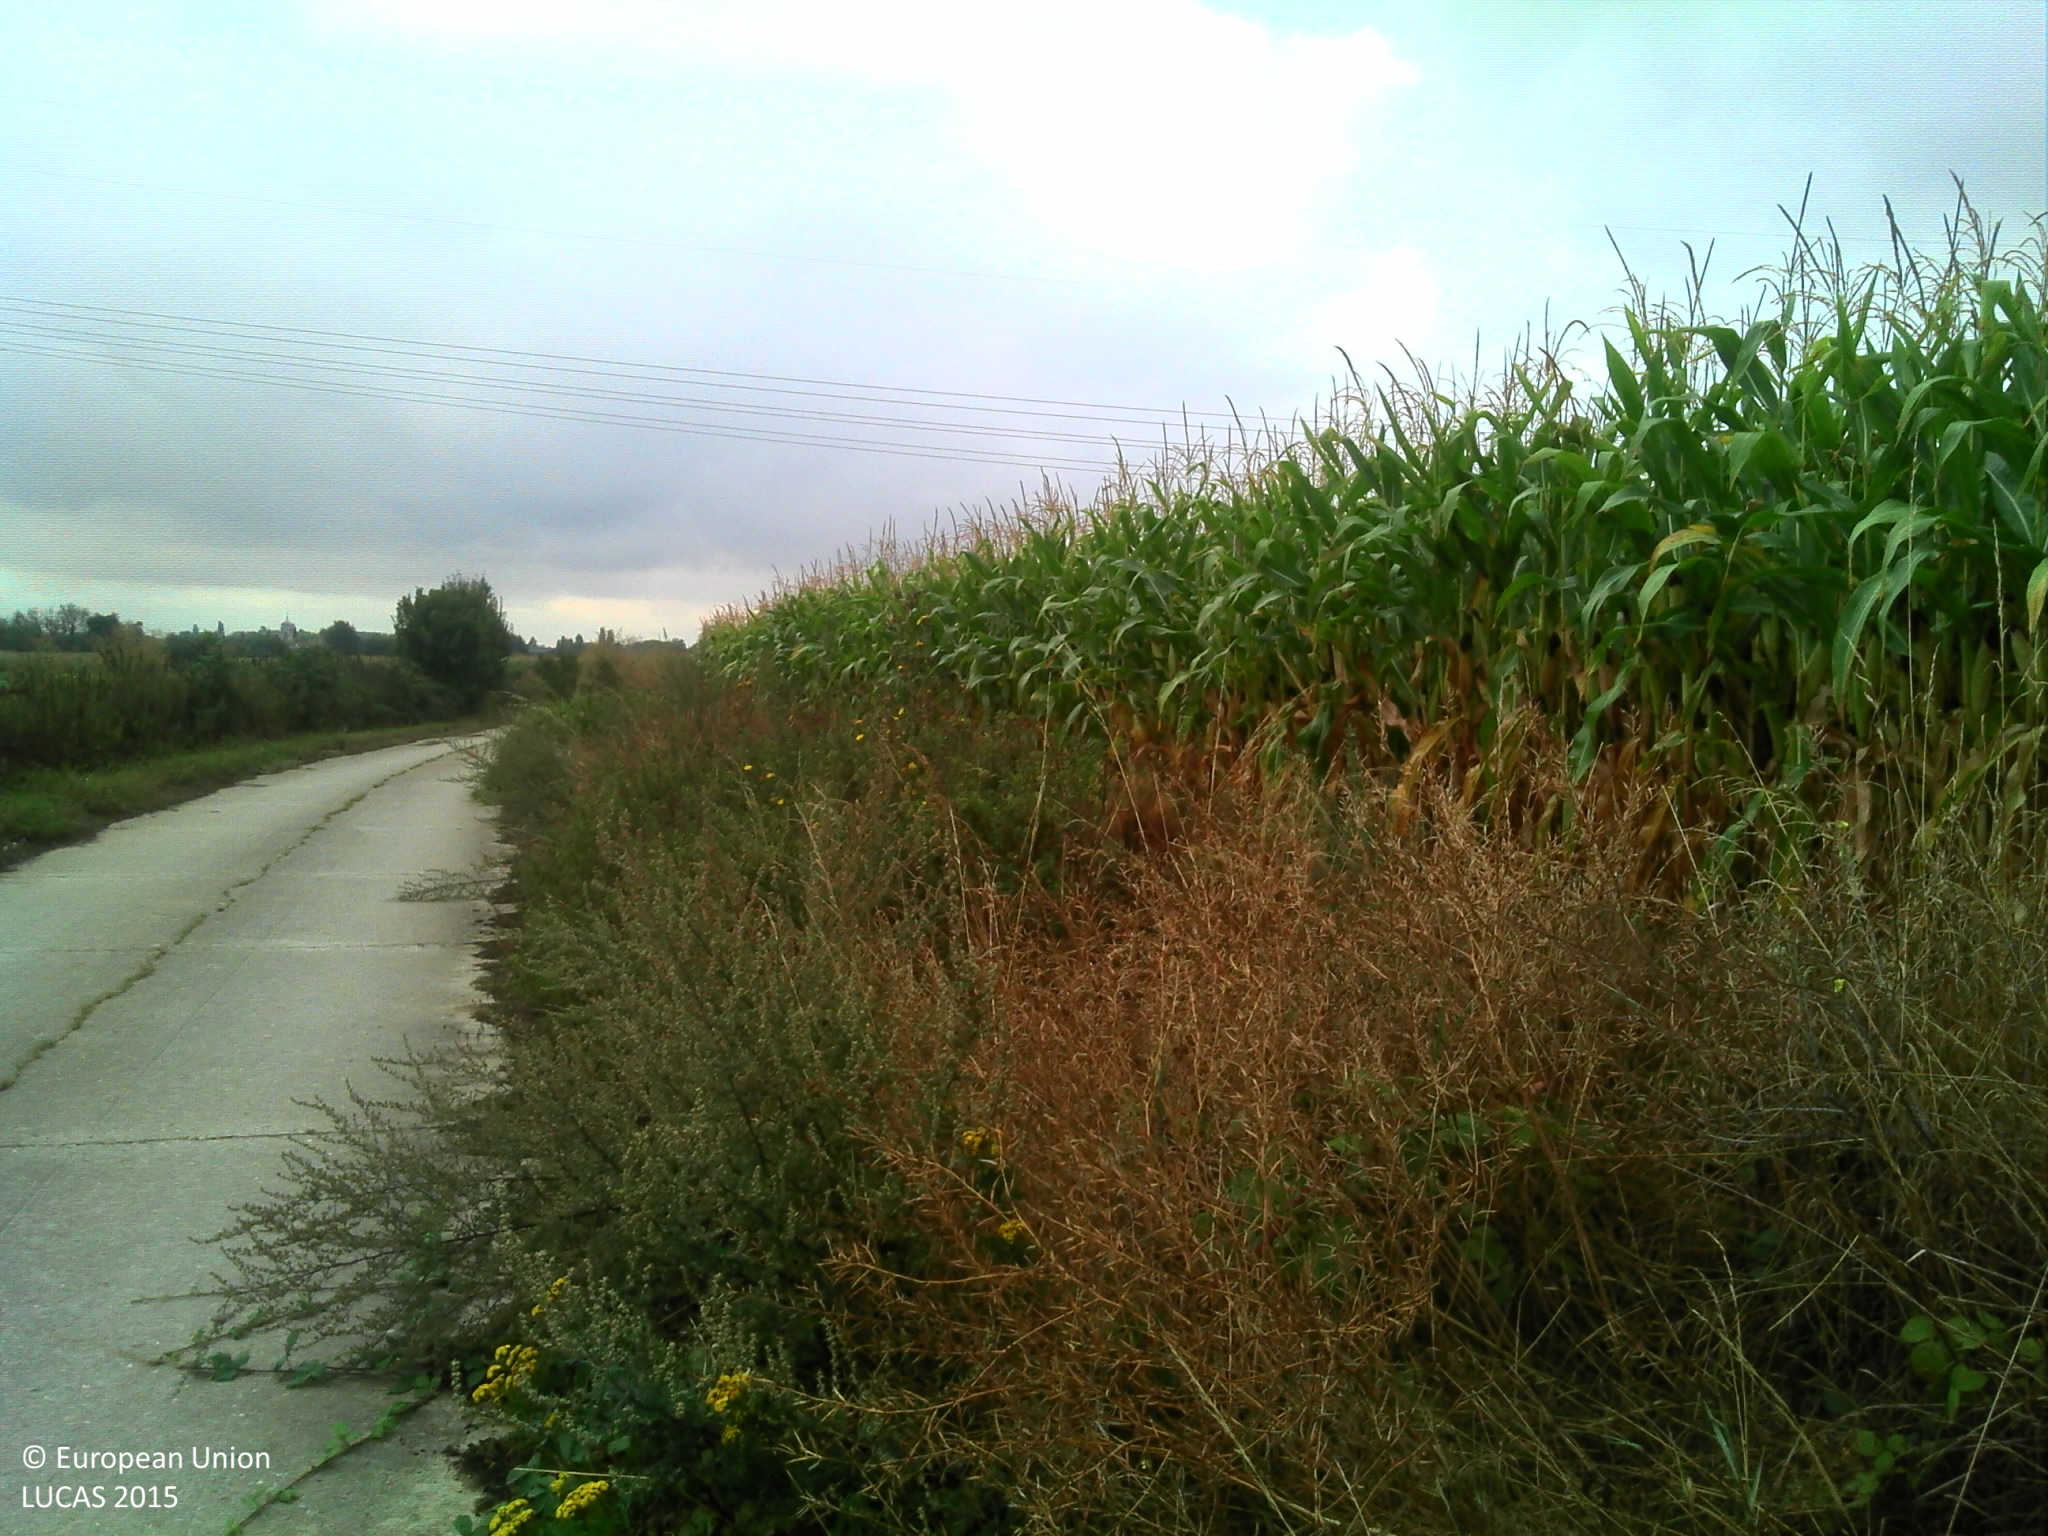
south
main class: Cropland
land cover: Maize
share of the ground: > 75 %
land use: Agriculture (excluding fallow land and kitchen gardens)
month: August
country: FR
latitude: 49.0627
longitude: 2.3921
